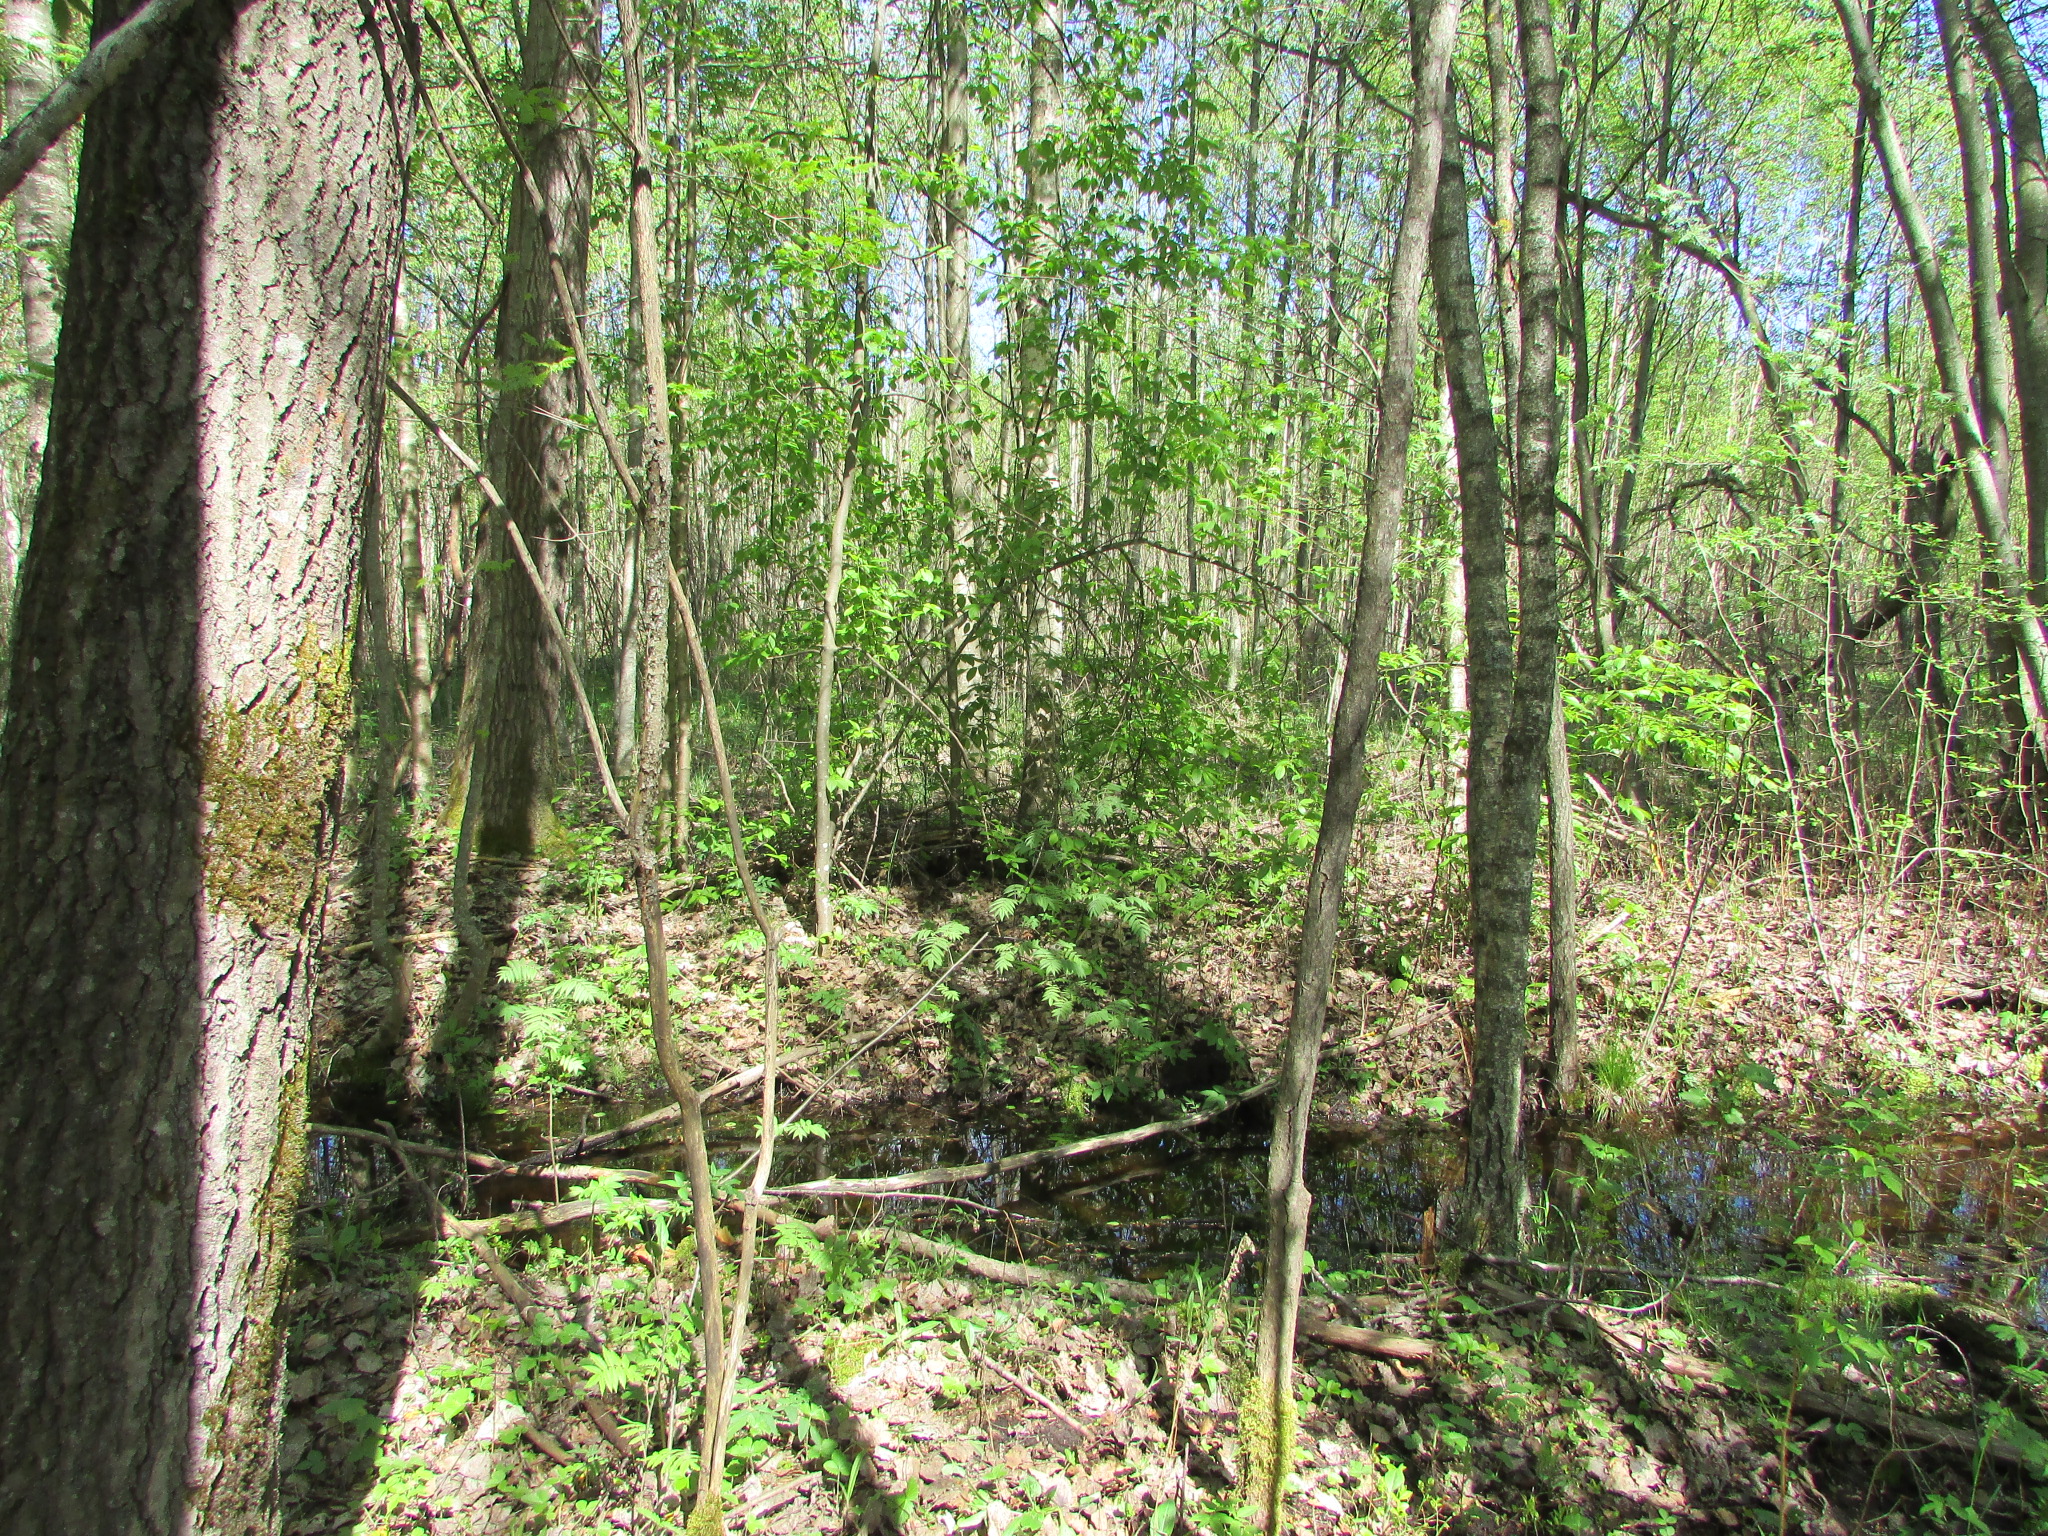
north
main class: Woodland
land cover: Broadleaved woodland
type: floodplain forest
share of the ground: > 75 %
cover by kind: broadleaved forest trees 100 %
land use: Forestry
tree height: > 5 m
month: May
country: LV
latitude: 56.0486
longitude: 27.0402
